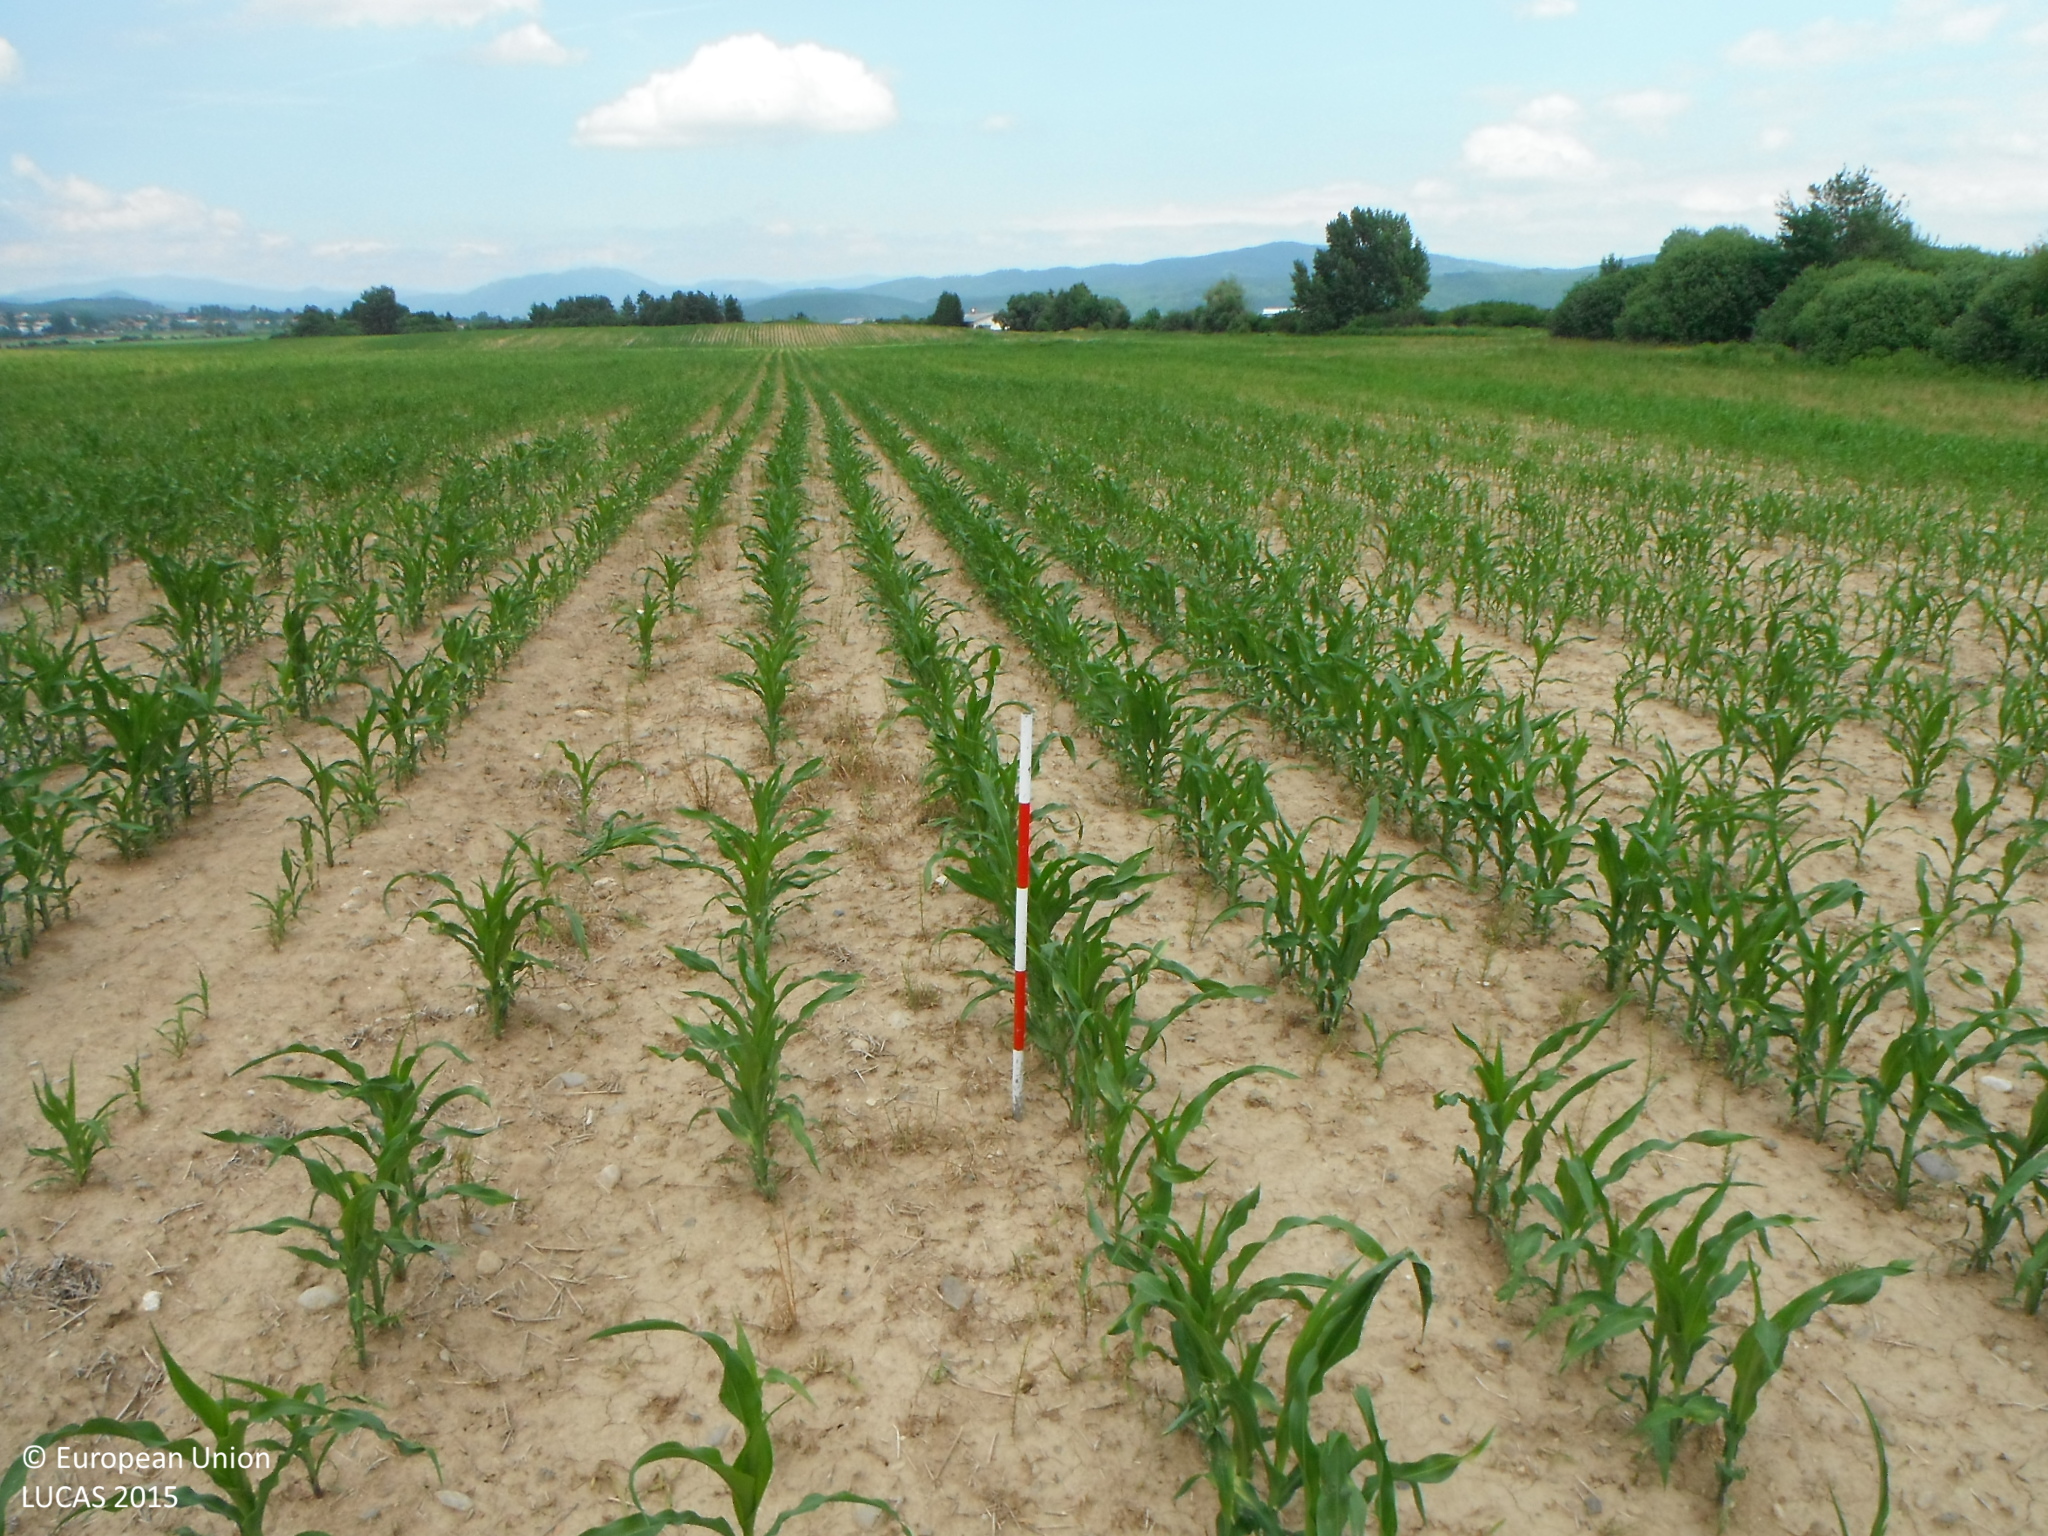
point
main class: Cropland
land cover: Maize
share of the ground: 25 - 50 %
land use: Agriculture (excluding fallow land and kitchen gardens)
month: June
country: SK
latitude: 48.6408
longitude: 19.1283
